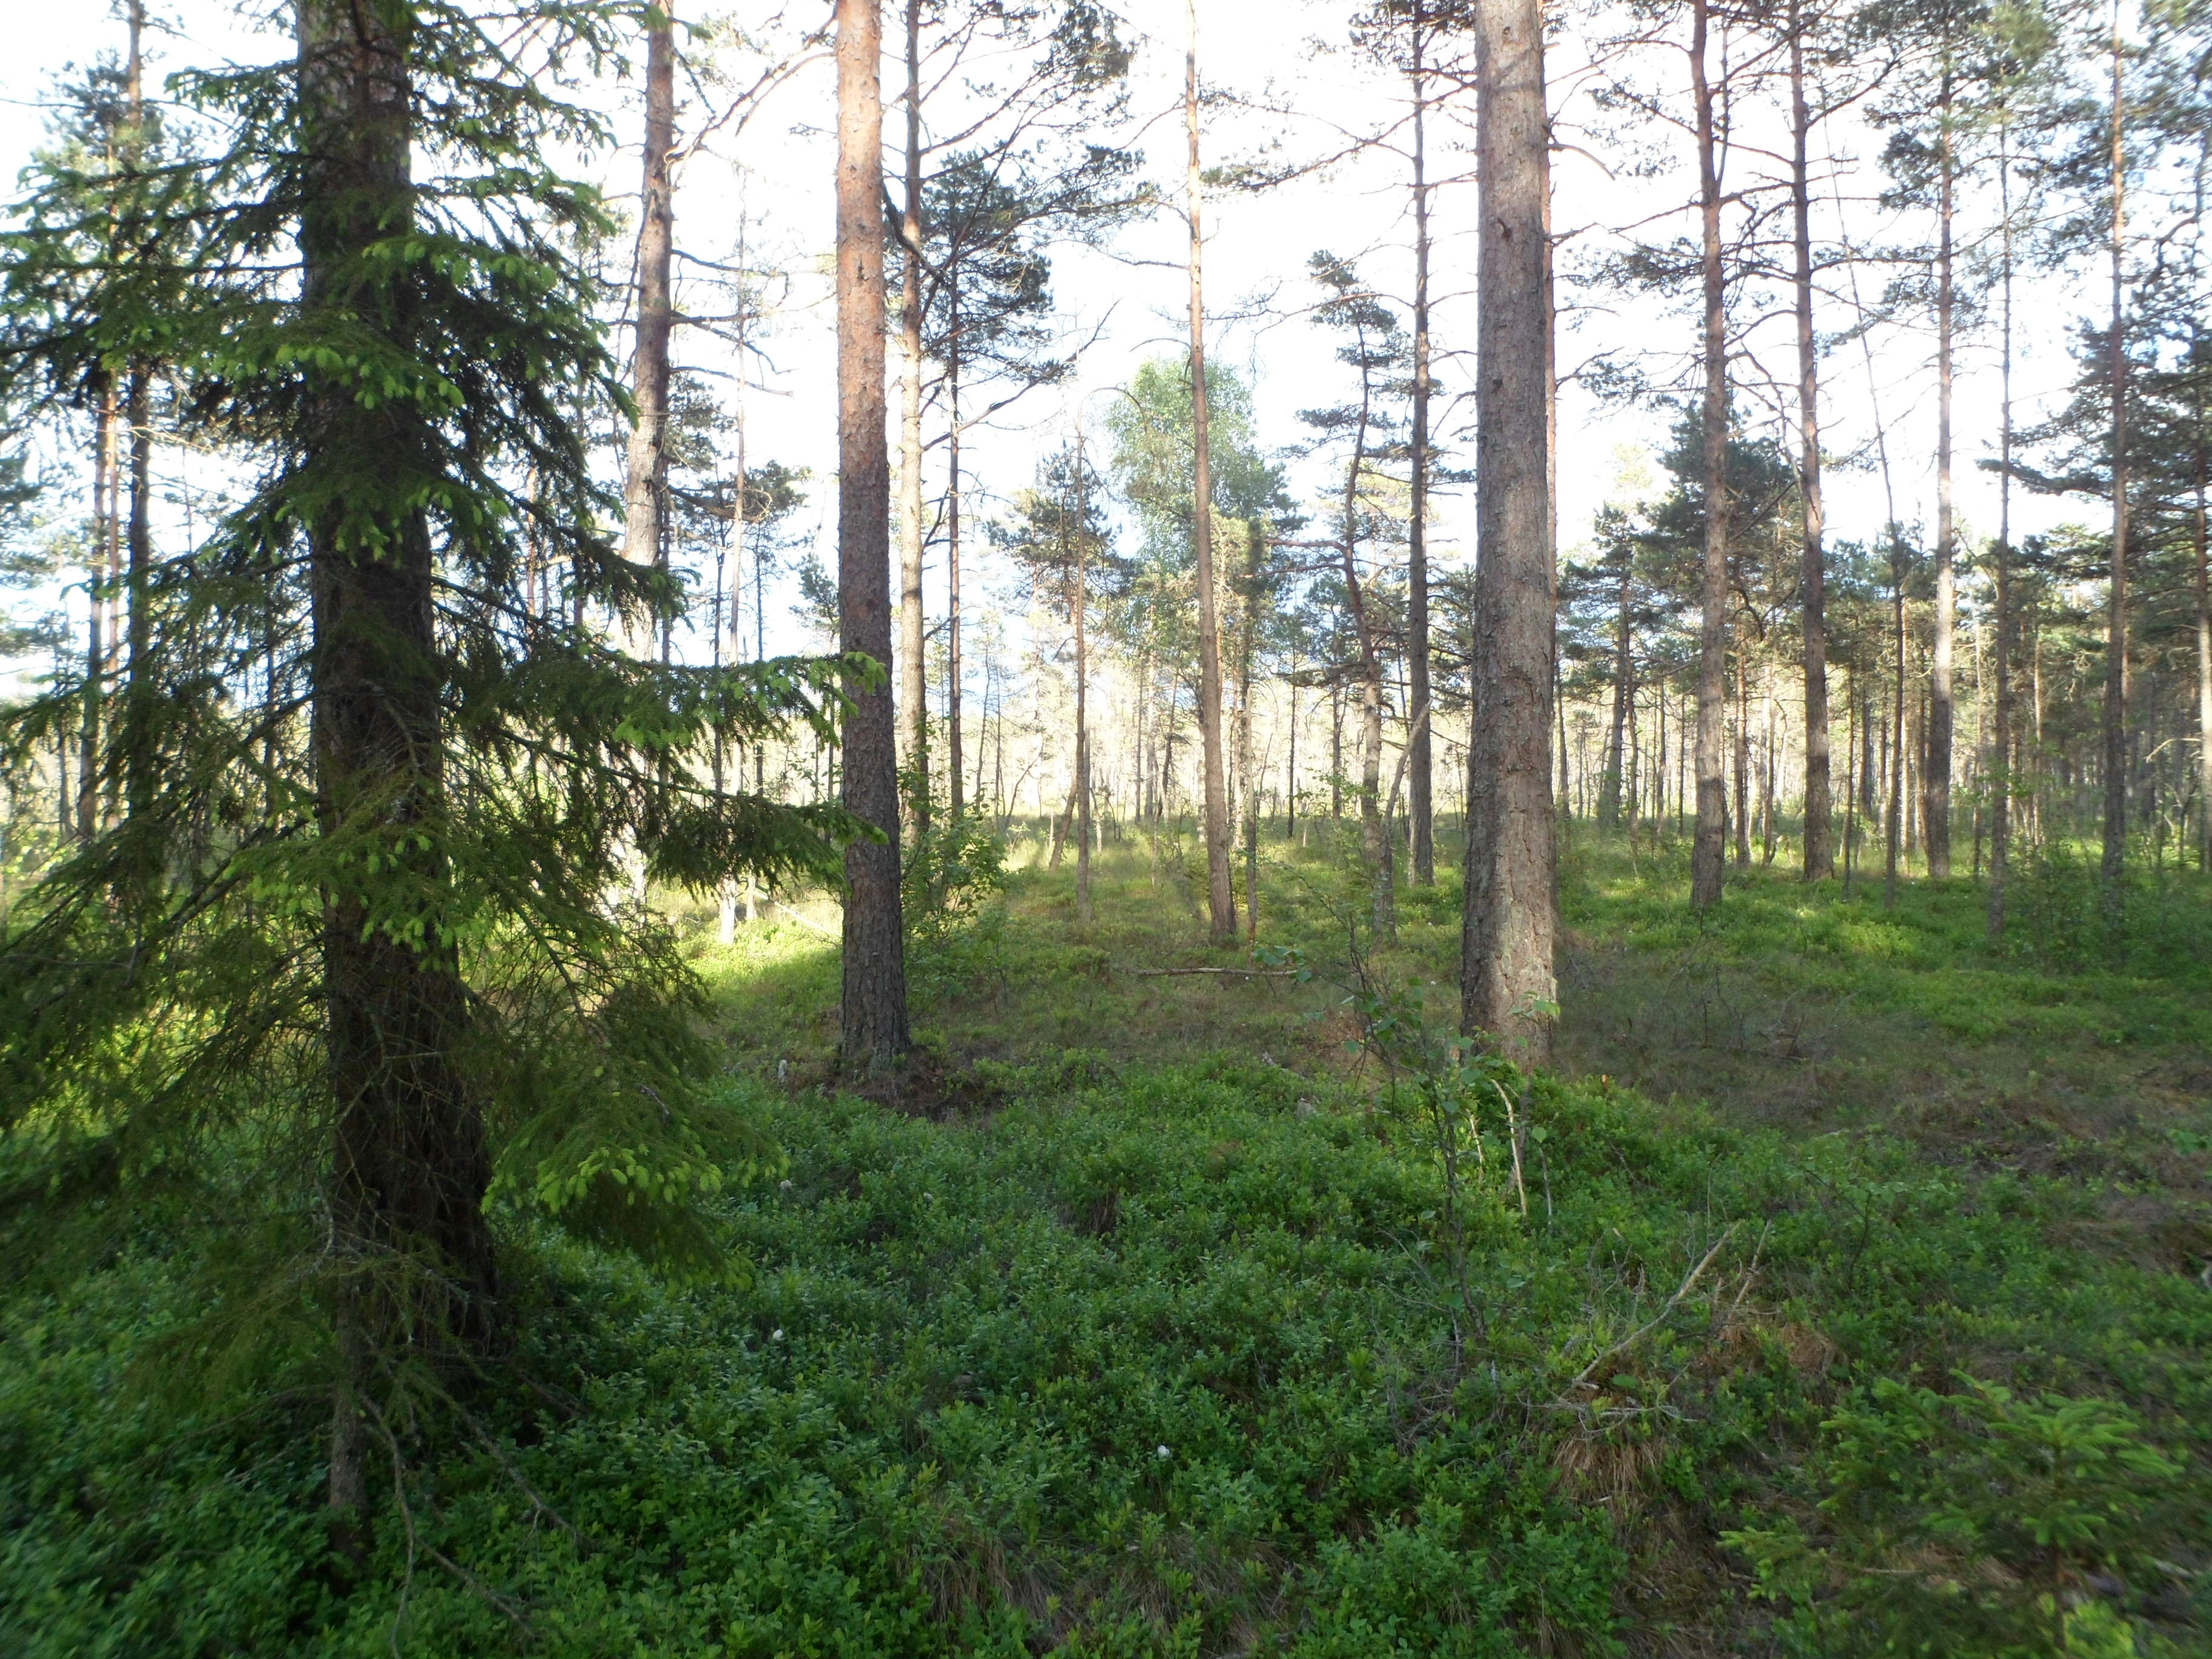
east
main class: Woodland
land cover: Pine dominated coniferous woodland
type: boreal forest
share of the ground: 25 - 50 %
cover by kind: coniferous forest trees 45 %, shrubs 25 %, lichens and mosses 15 %, herbaceous plants 10 %, broadleaved forest trees 5 %
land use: Forestry
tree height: > 5 m
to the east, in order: Pine dominated coniferous woodland; Ditches and canals; Pine dominated coniferous woodland; Ditches and canals; Pine dominated coniferous woodland
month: June
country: SE
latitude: 57.1661
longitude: 14.1137
